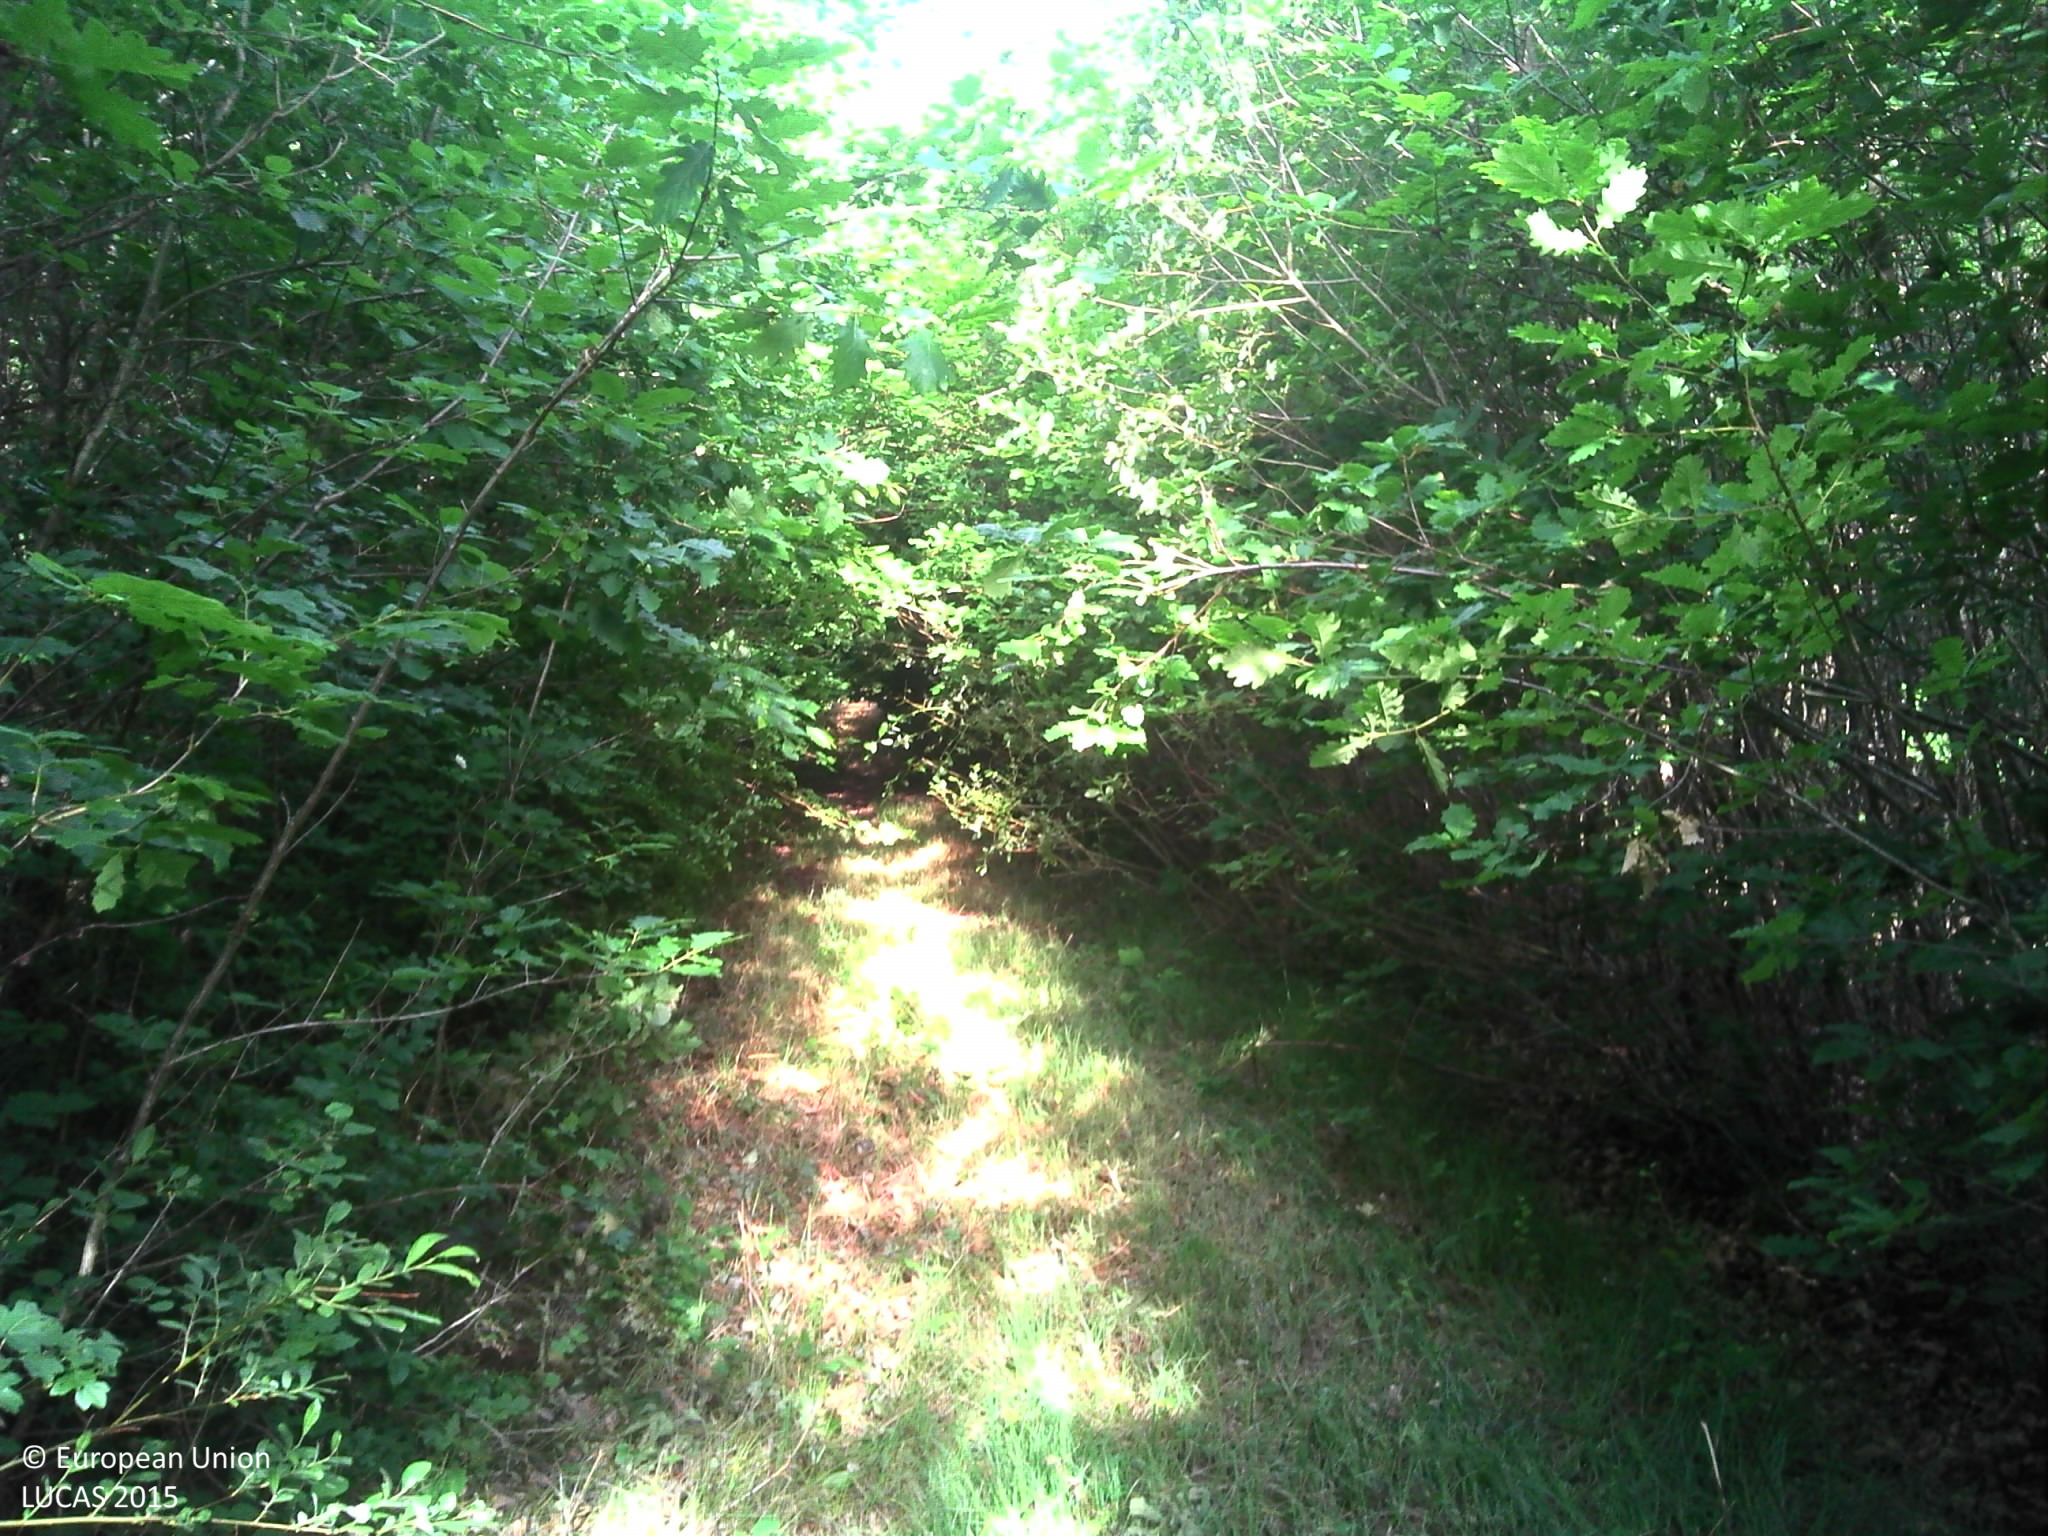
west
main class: Woodland
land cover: Broadleaved woodland
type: mesophytic deciduous forest
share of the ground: > 75 %
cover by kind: broadleaved forest trees 95 %, herbaceous plants 5 %
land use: Forestry
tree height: < 5 m
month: June
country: FR
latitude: 47.5602
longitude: 1.3863
